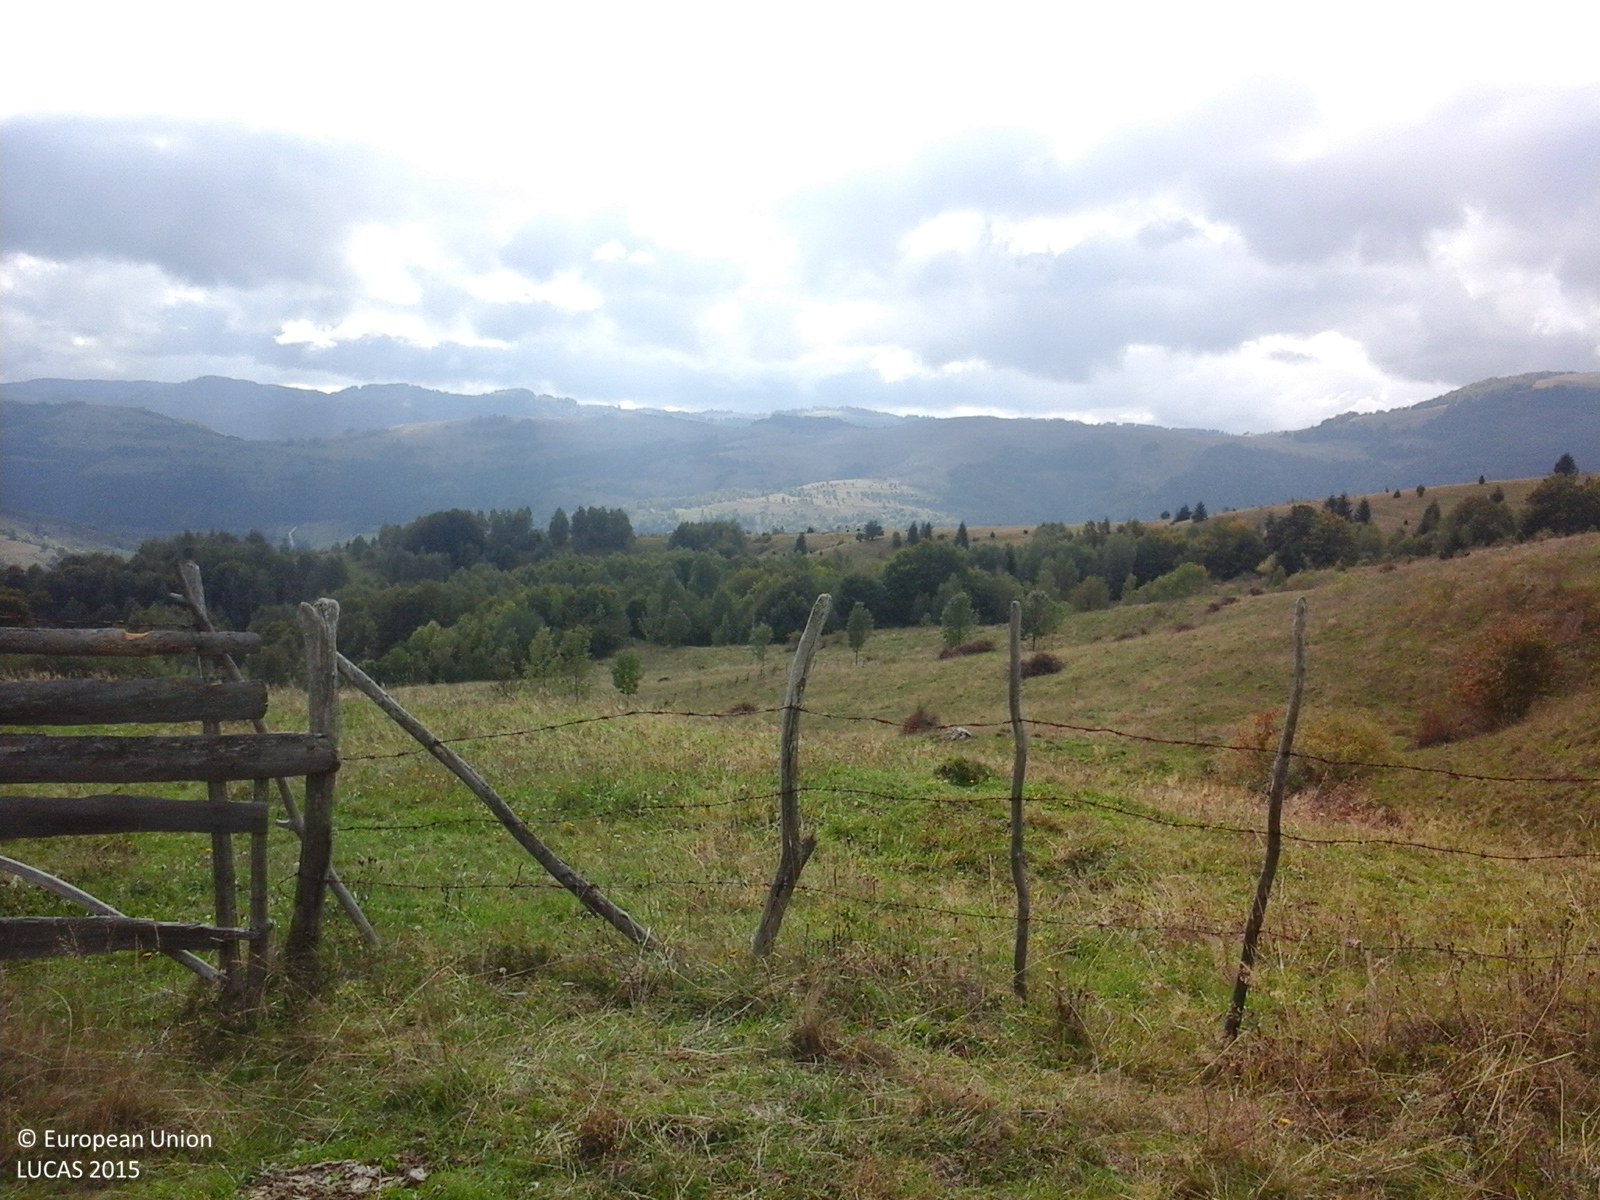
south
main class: Grassland
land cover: Grassland without tree/shrub cover
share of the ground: > 75 %
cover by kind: herbaceous plants 100 %
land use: Agriculture (excluding fallow land and kitchen gardens)
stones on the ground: 10 - 25 %
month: October
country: RO
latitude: 46.2872
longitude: 23.2627
